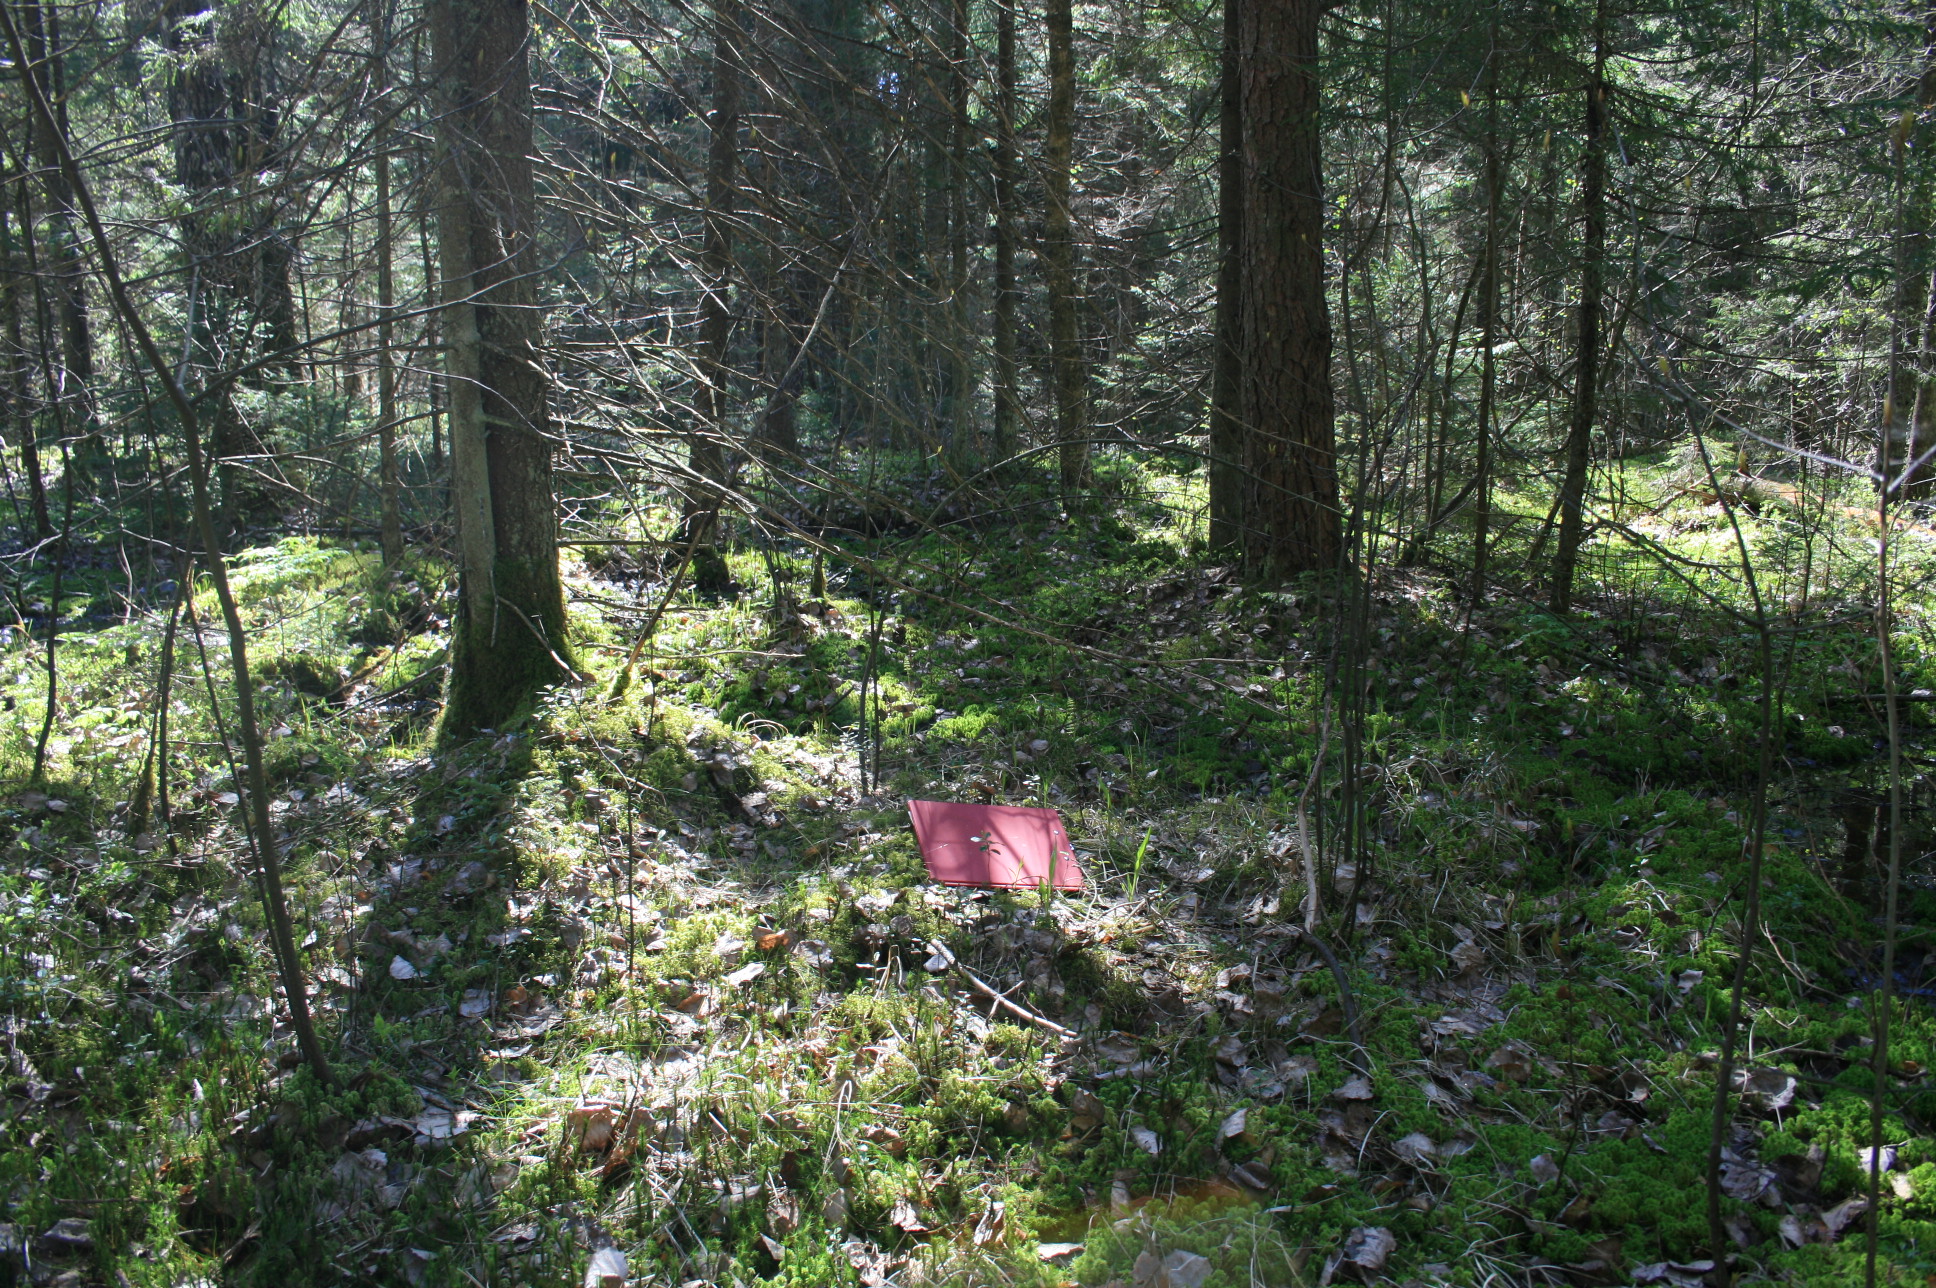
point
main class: Woodland
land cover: Other mixed woodland
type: hemiboreal forest and nemoral coniferous forest and mixed broadleaved-coniferous forest
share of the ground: > 75 %
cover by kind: coniferous forest trees 65 %, broadleaved forest trees 35 %
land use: Forestry
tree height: > 5 m
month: May
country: LT
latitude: 56.0365
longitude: 21.4548
